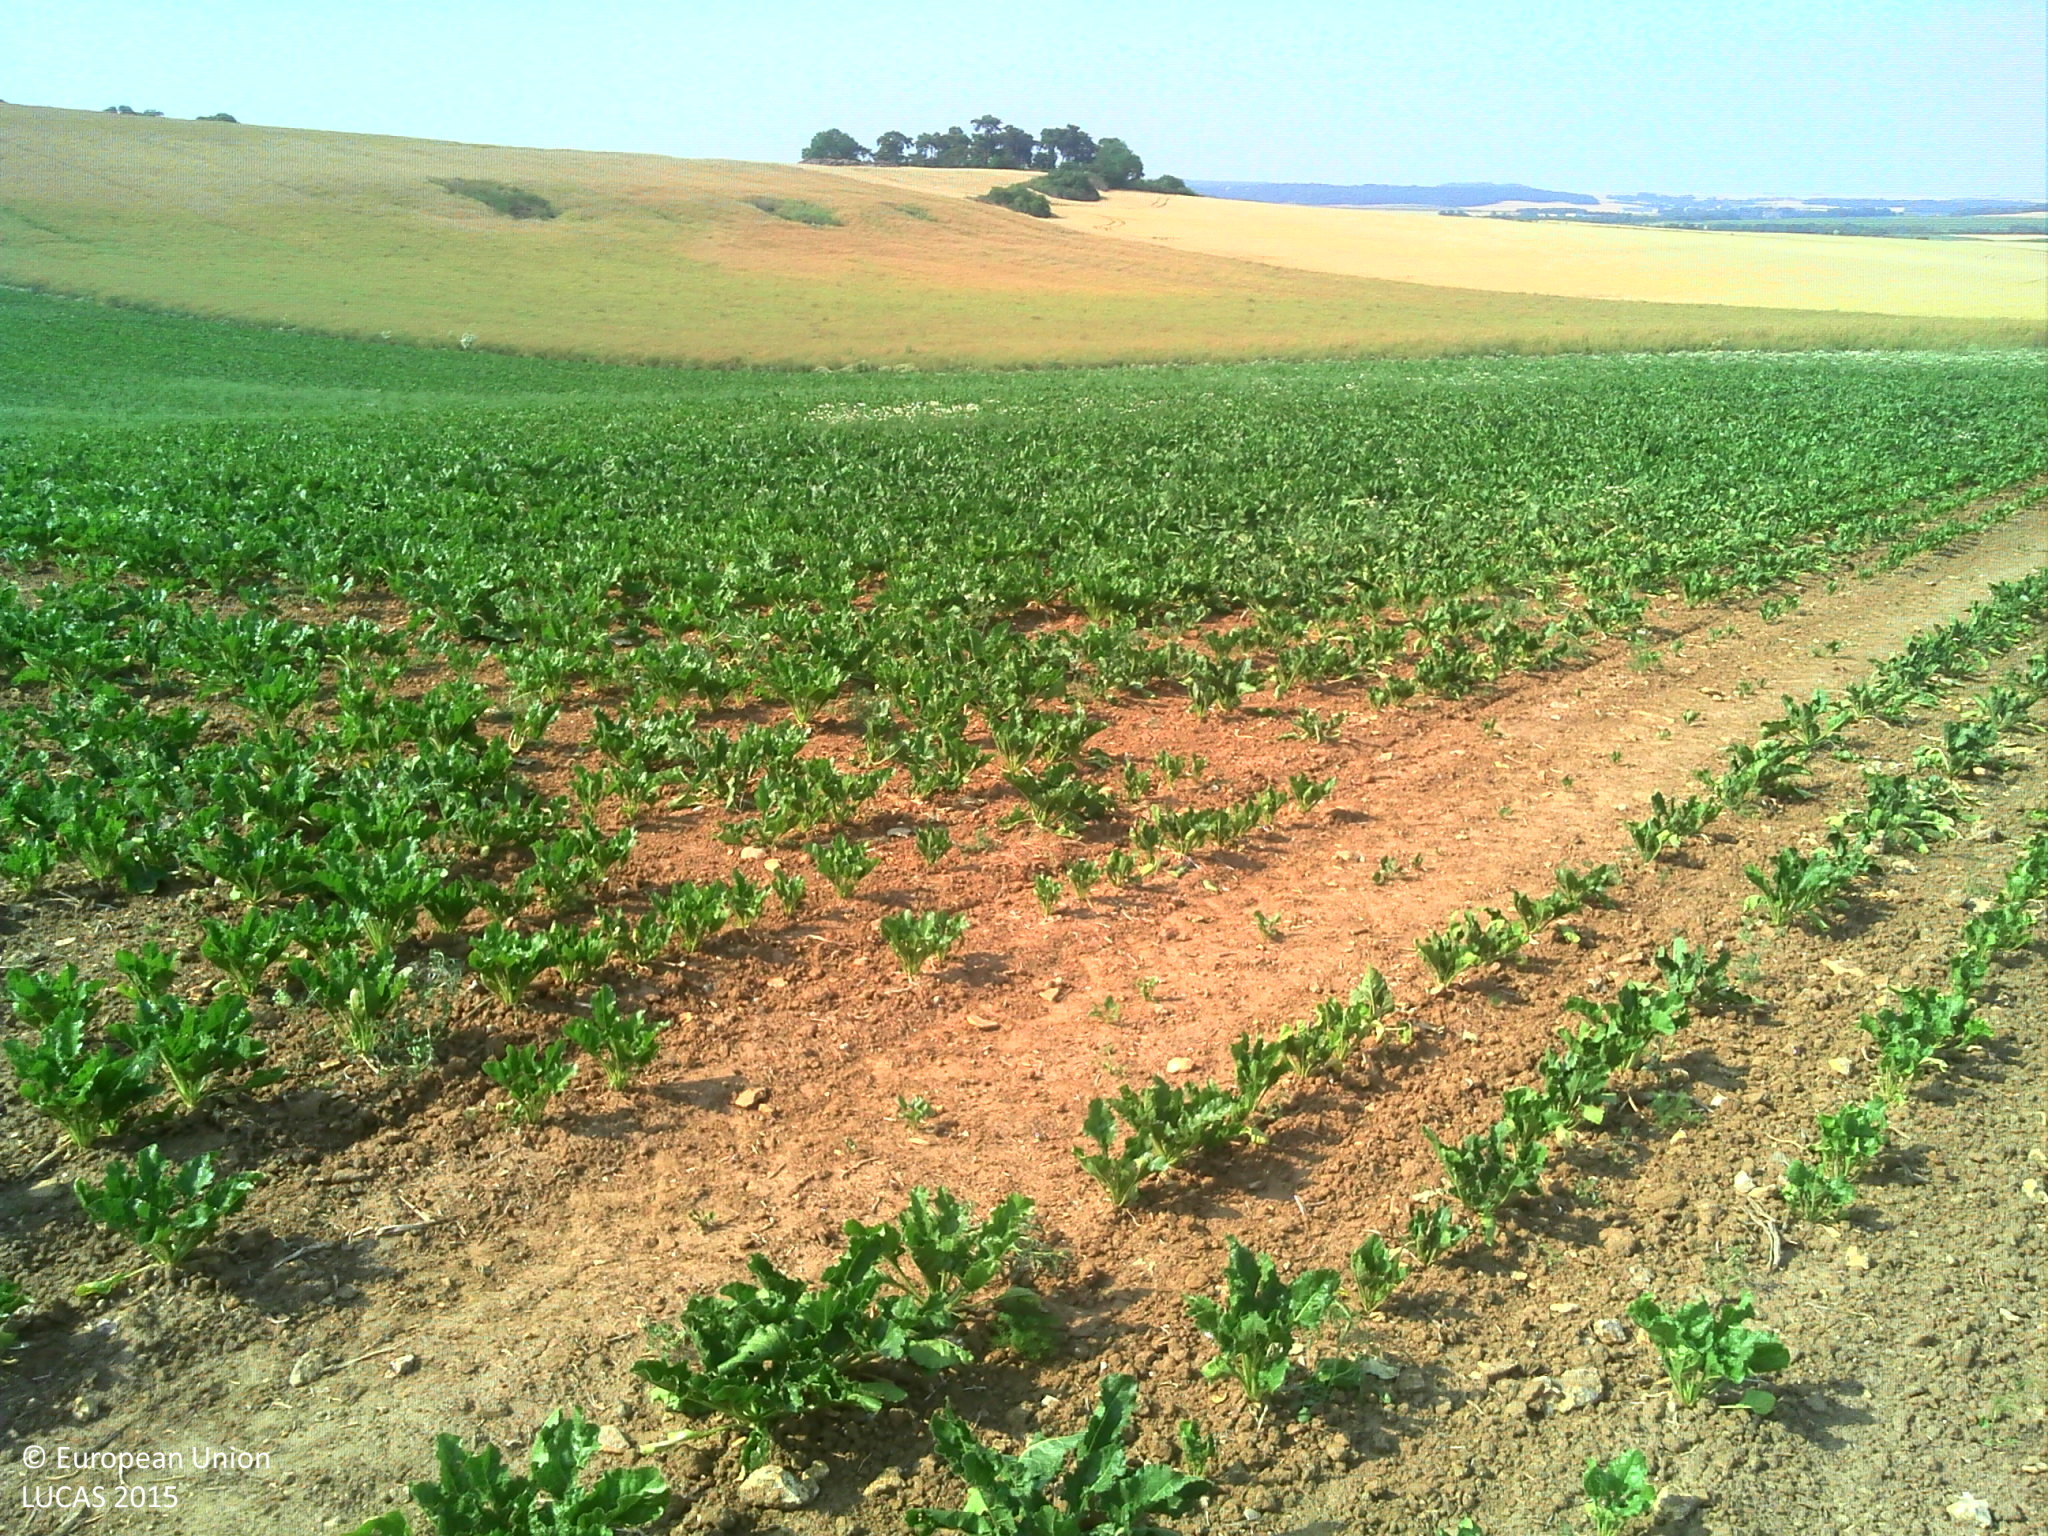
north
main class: Cropland
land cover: Sugar beet
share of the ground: 50 - 75 %
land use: Agriculture (excluding fallow land and kitchen gardens)
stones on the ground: < 10 %
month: July
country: FR
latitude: 49.1595
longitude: 3.3418
